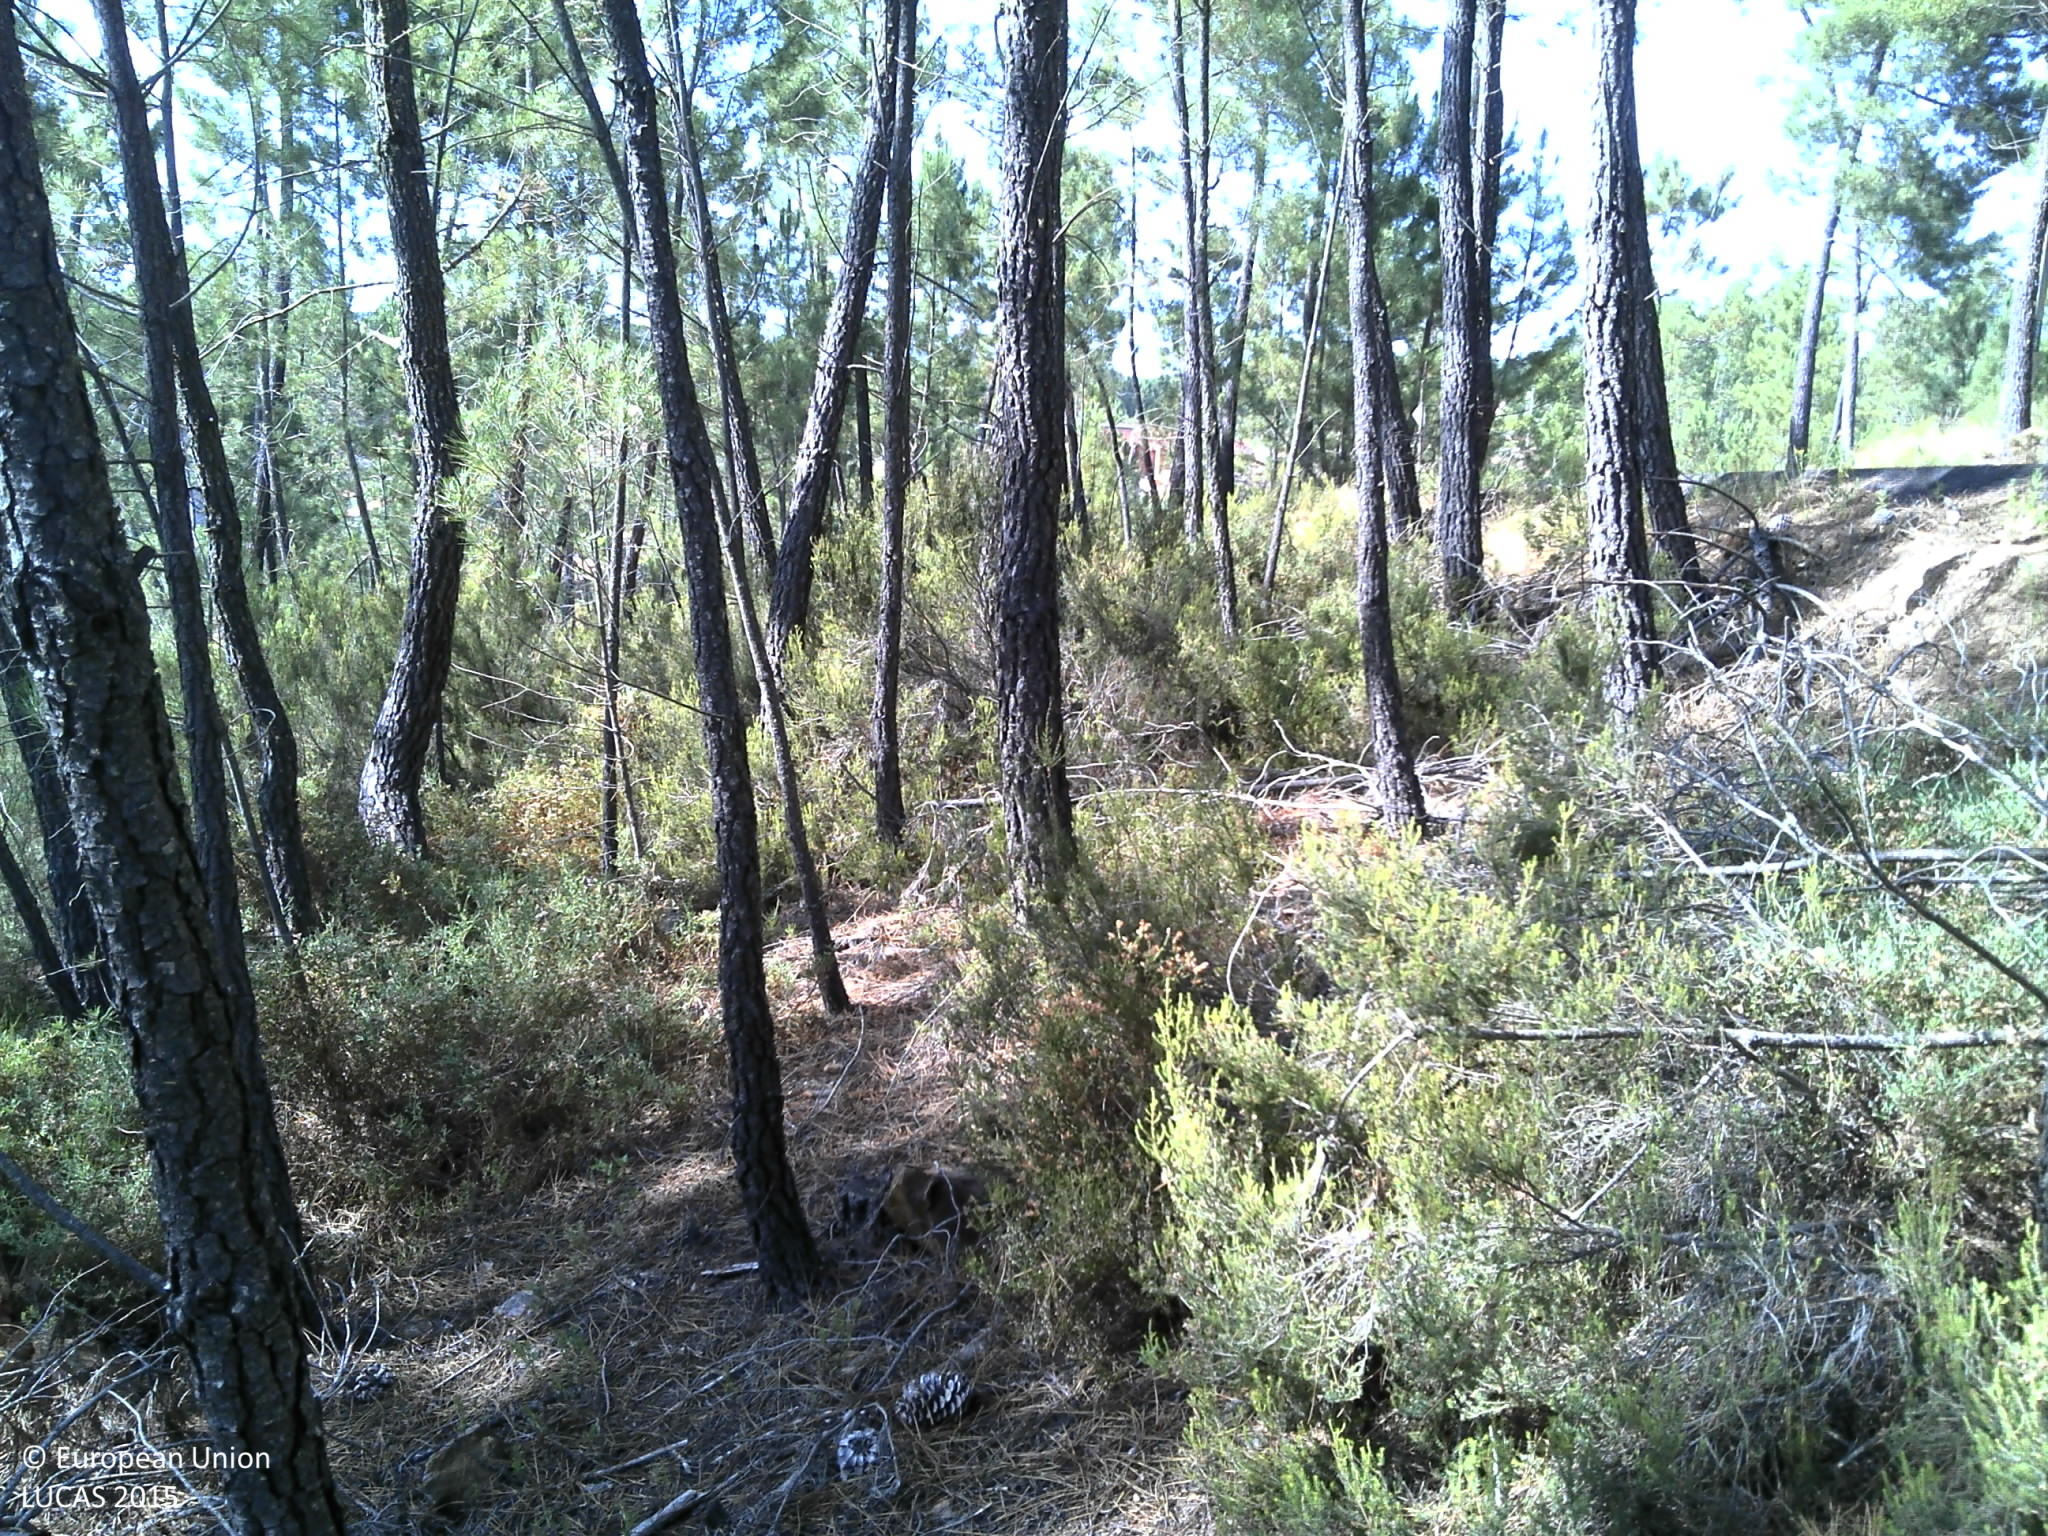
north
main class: Woodland
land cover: Pine dominated coniferous woodland
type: coniferous forest of the mediterranean region
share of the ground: 10 - 25 %
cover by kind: unconsolidated bare surface 65 %, shrubs 20 %, coniferous forest trees 15 %
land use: Forestry
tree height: > 5 m
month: July
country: PT
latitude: 39.9427
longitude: -7.8647
